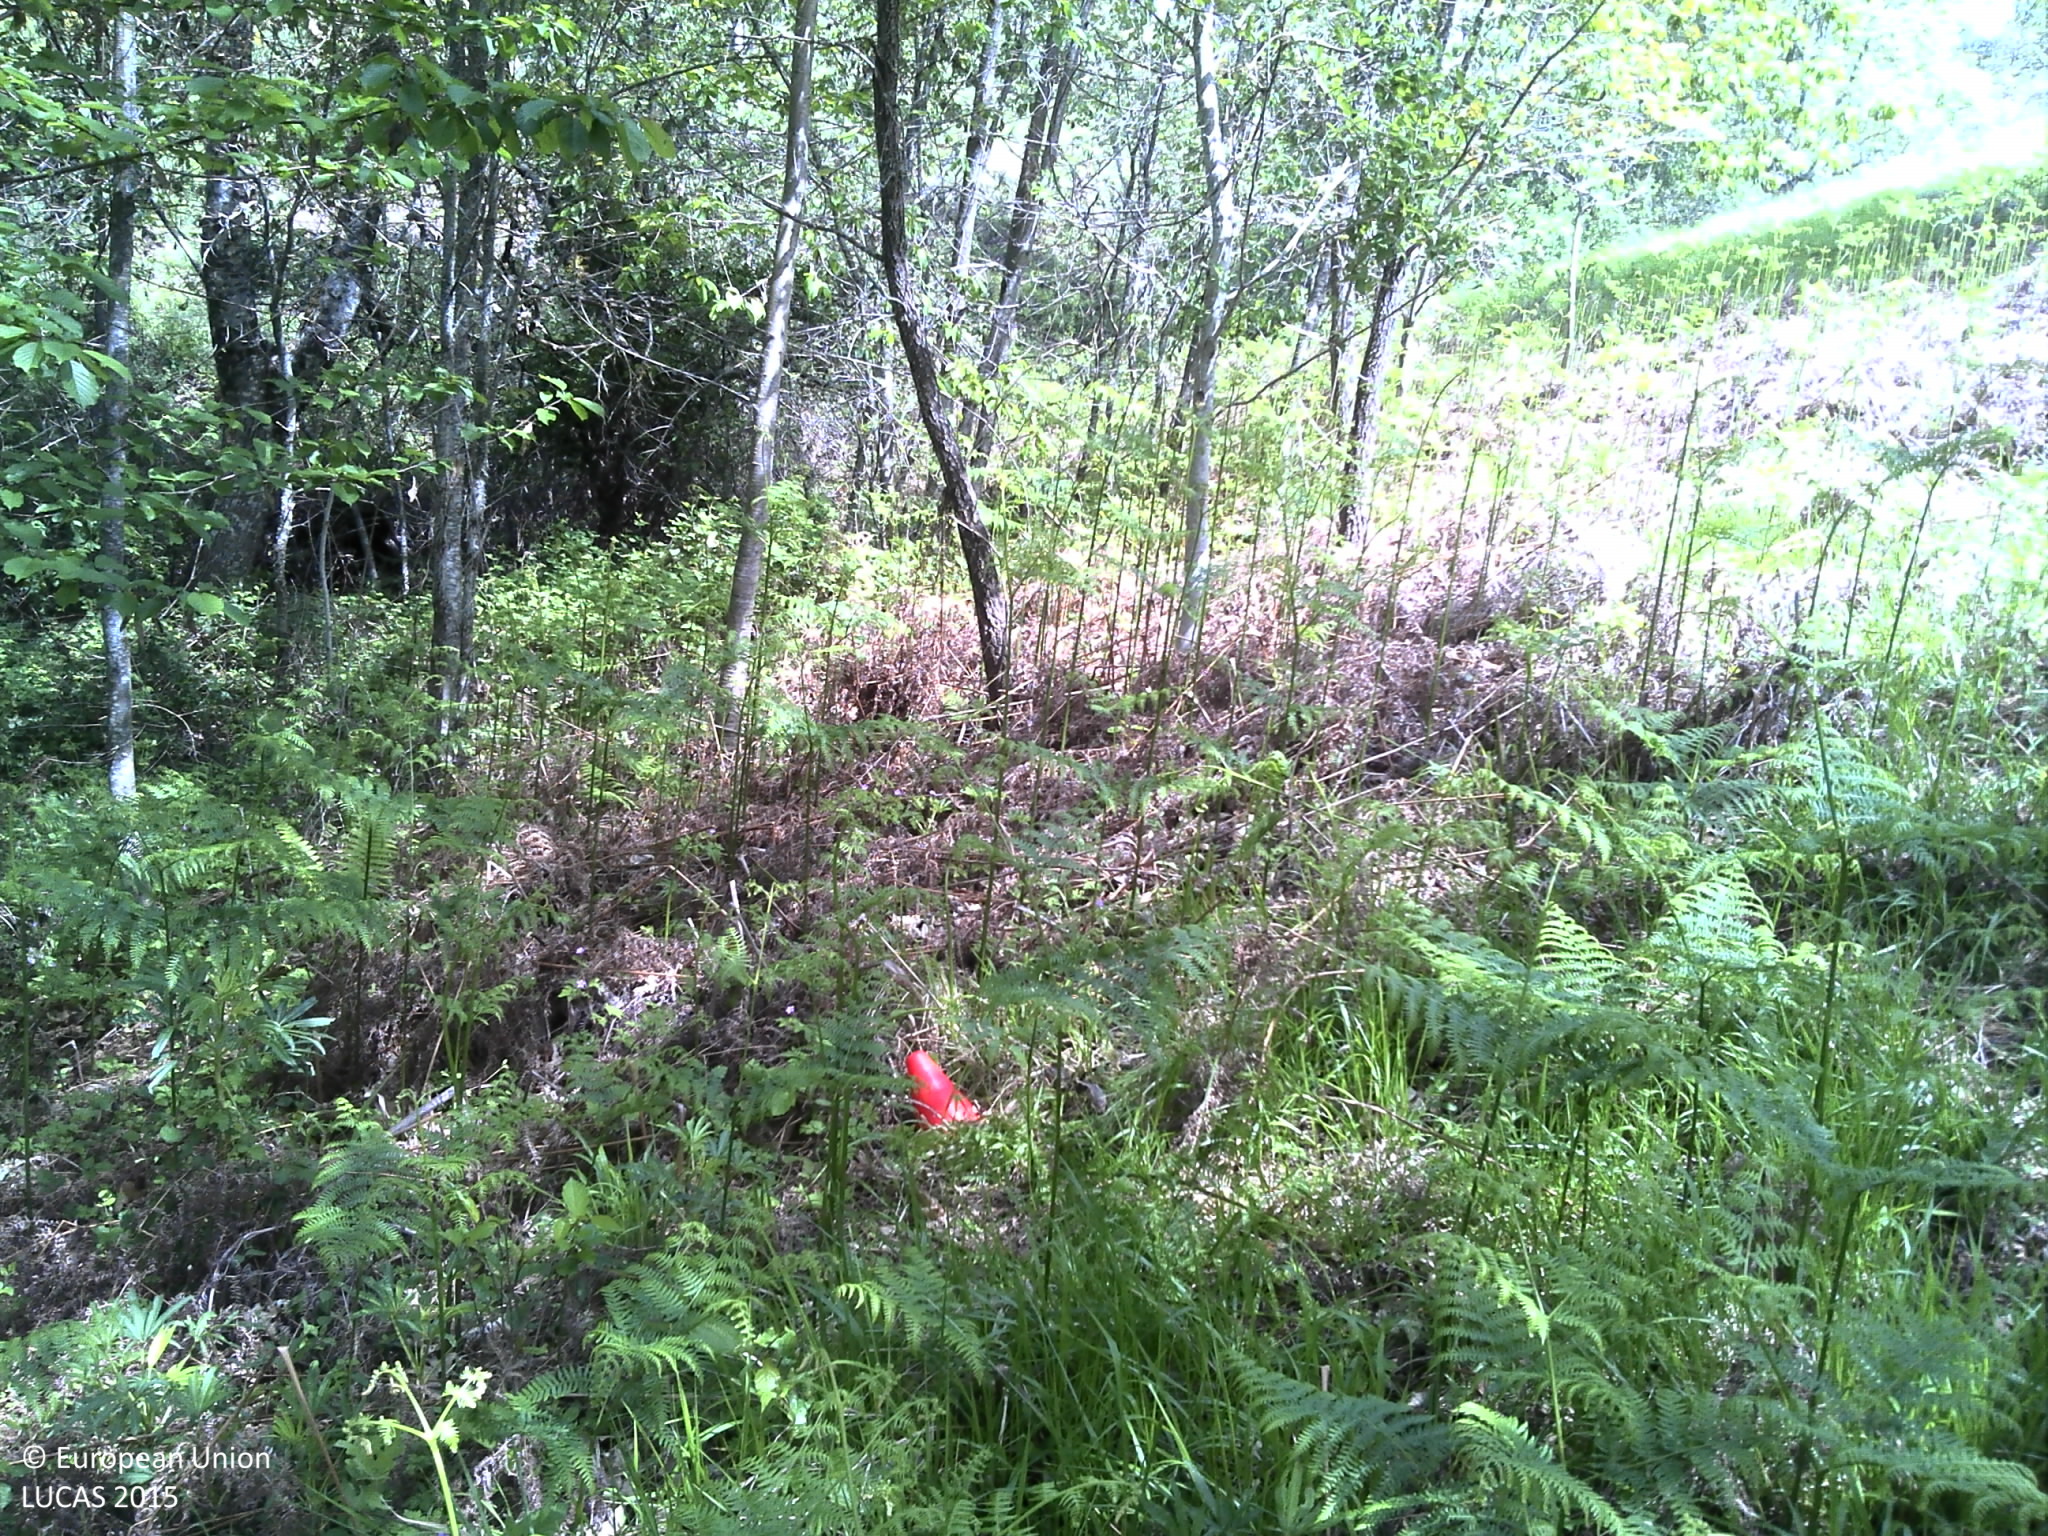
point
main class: Woodland
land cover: Broadleaved woodland
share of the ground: 25 - 50 %
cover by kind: broadleaved forest trees 50 %, unconsolidated bare surface 30 %, shrubs 10 %, herbaceous plants 10 %
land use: Forestry
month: May
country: PT
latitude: 41.8811
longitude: -7.0276
